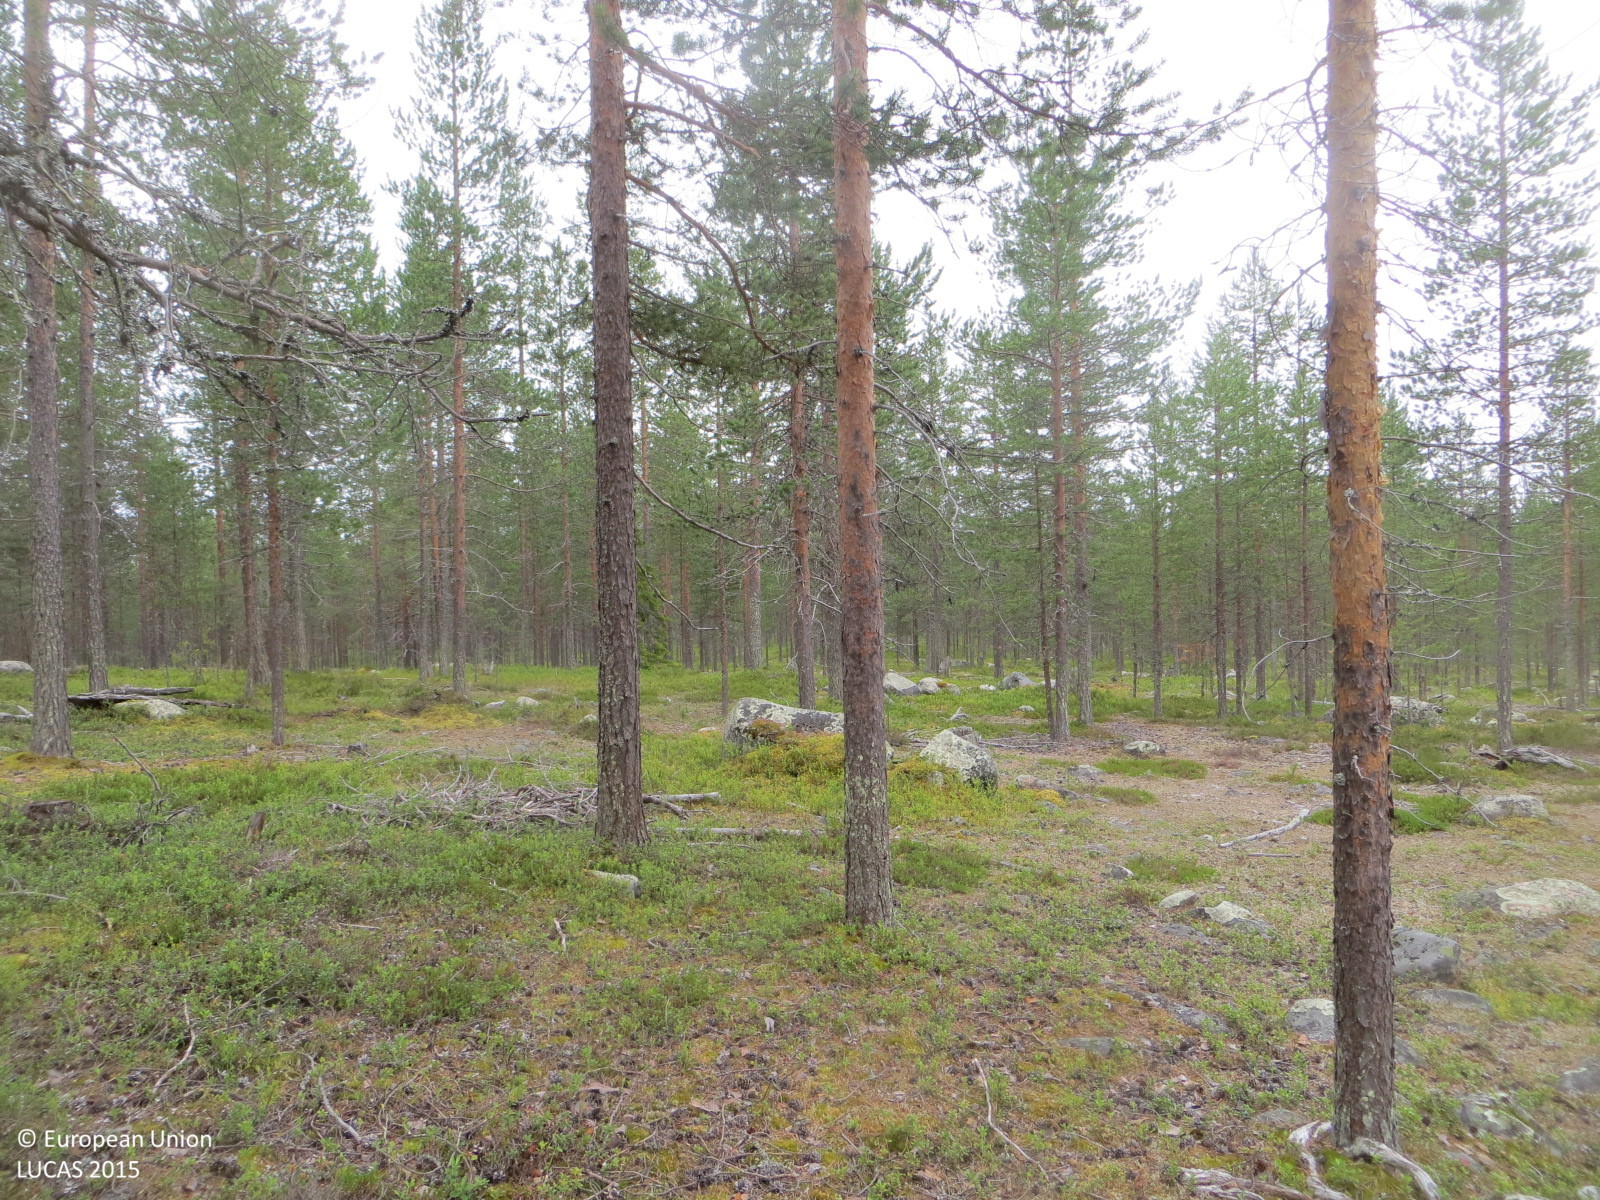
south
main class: Woodland
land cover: Pine dominated coniferous woodland
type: boreal forest
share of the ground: 50 - 75 %
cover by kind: coniferous forest trees 65 %, shrubs 35 %
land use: Forestry
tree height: > 5 m
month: July
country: FI
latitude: 66.4657
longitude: 24.2017
